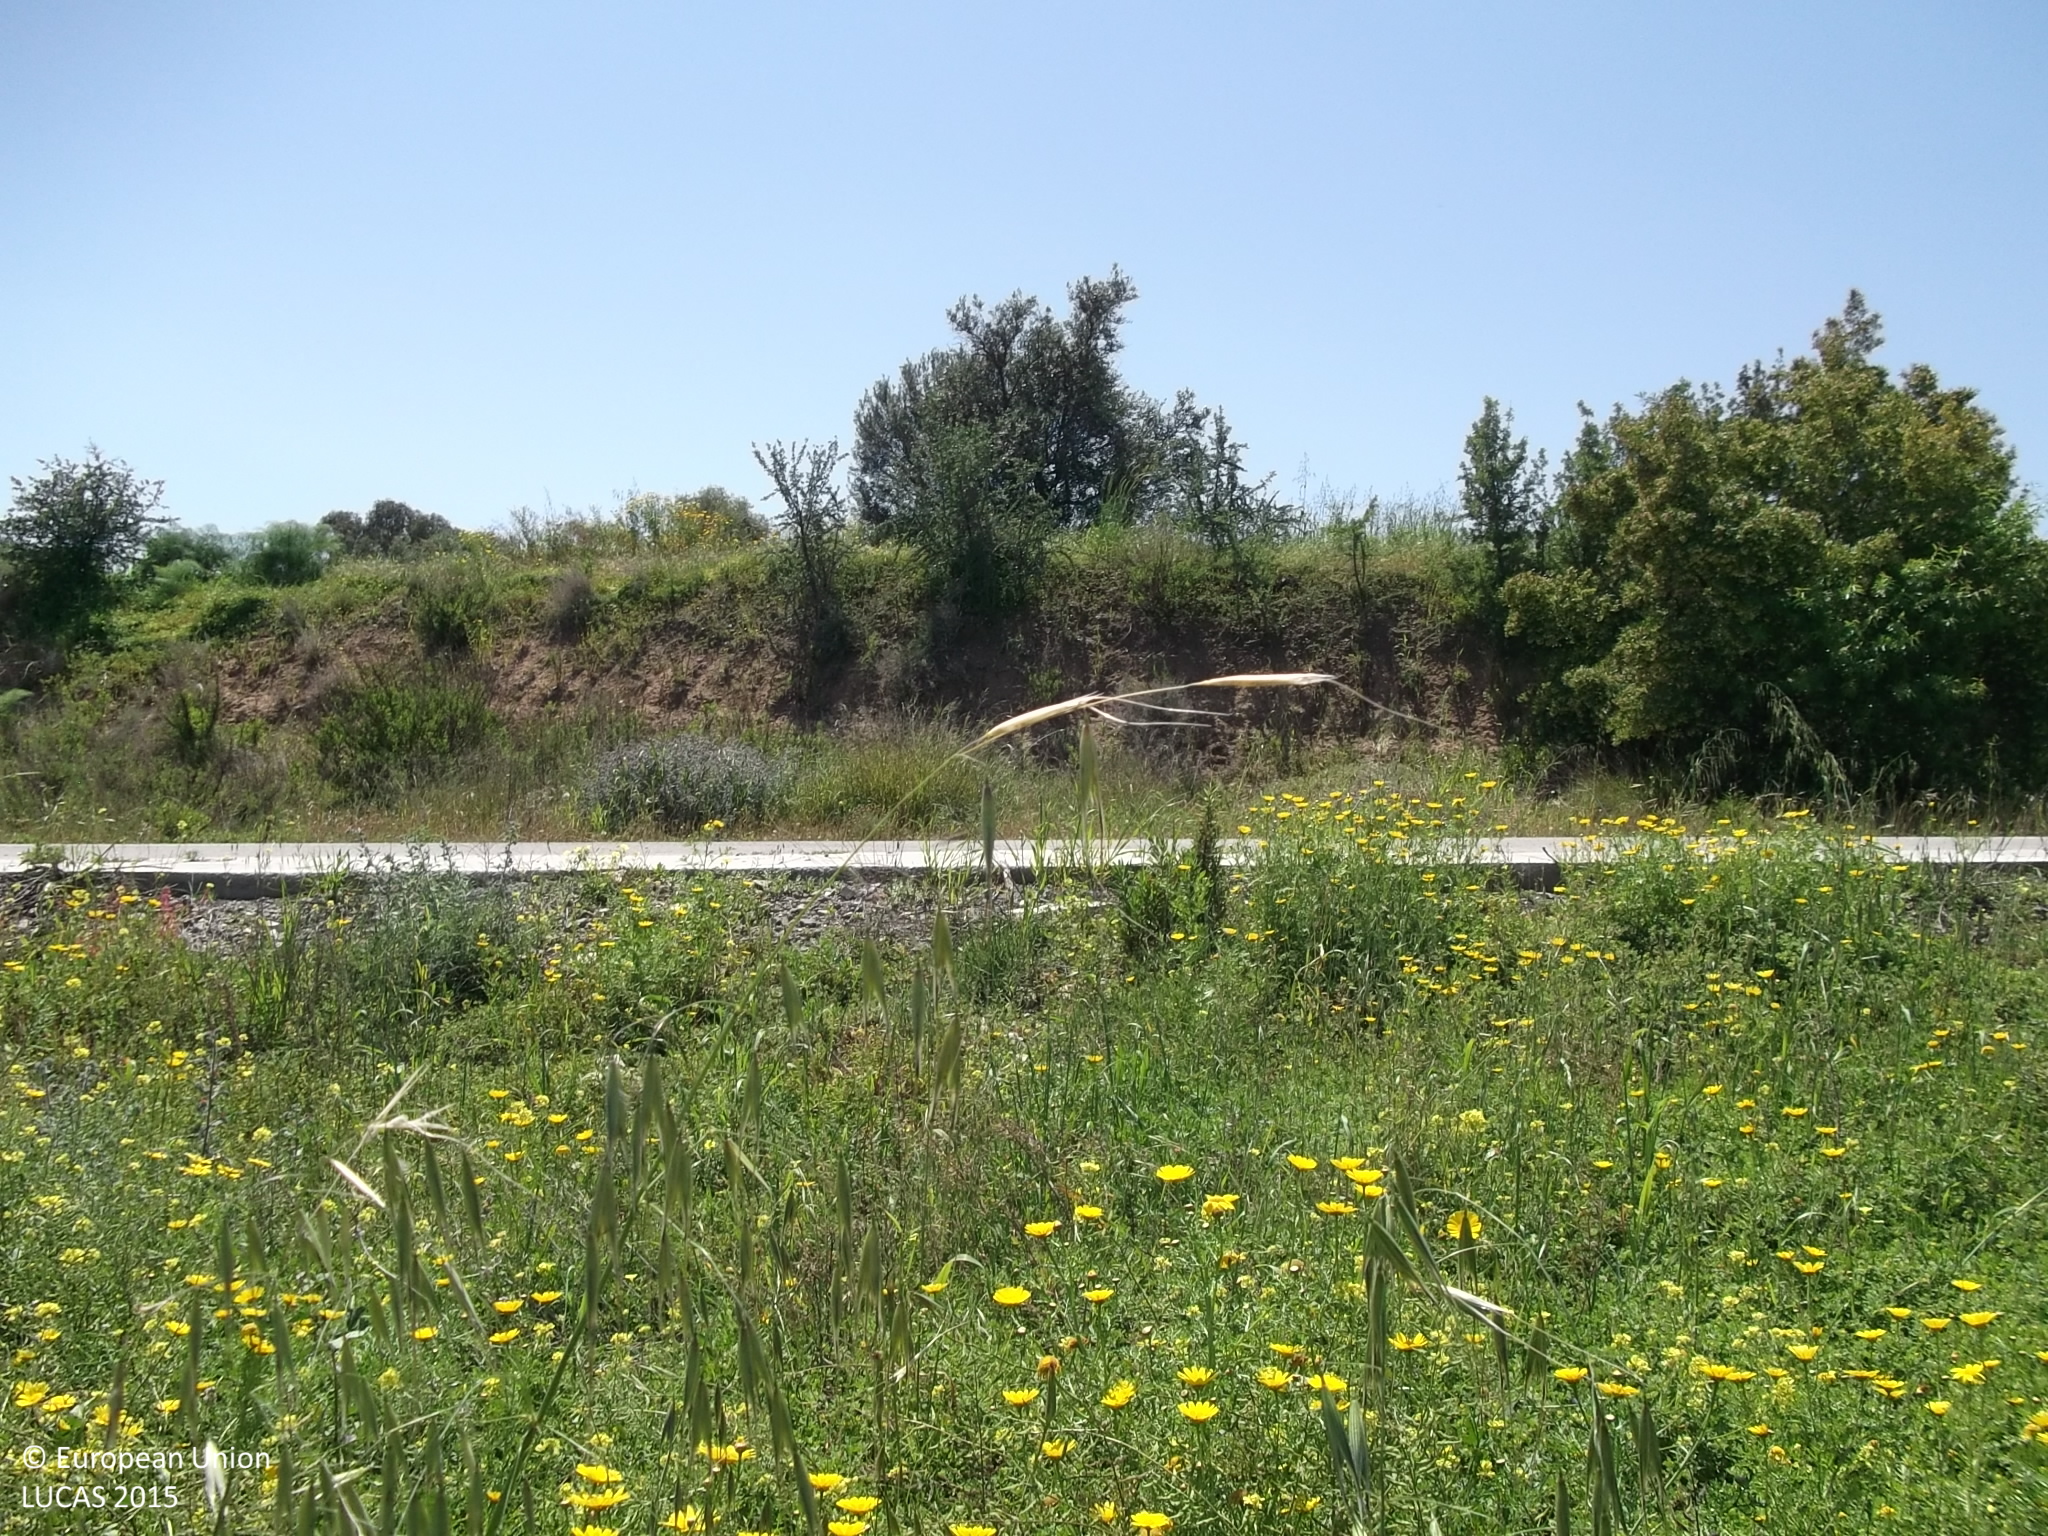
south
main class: Grassland
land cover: Spontaneously vegetated surfaces
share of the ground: > 75 %
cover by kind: herbaceous plants 100 %
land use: Residential
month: April
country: CY
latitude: 34.8534
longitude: 33.4961
